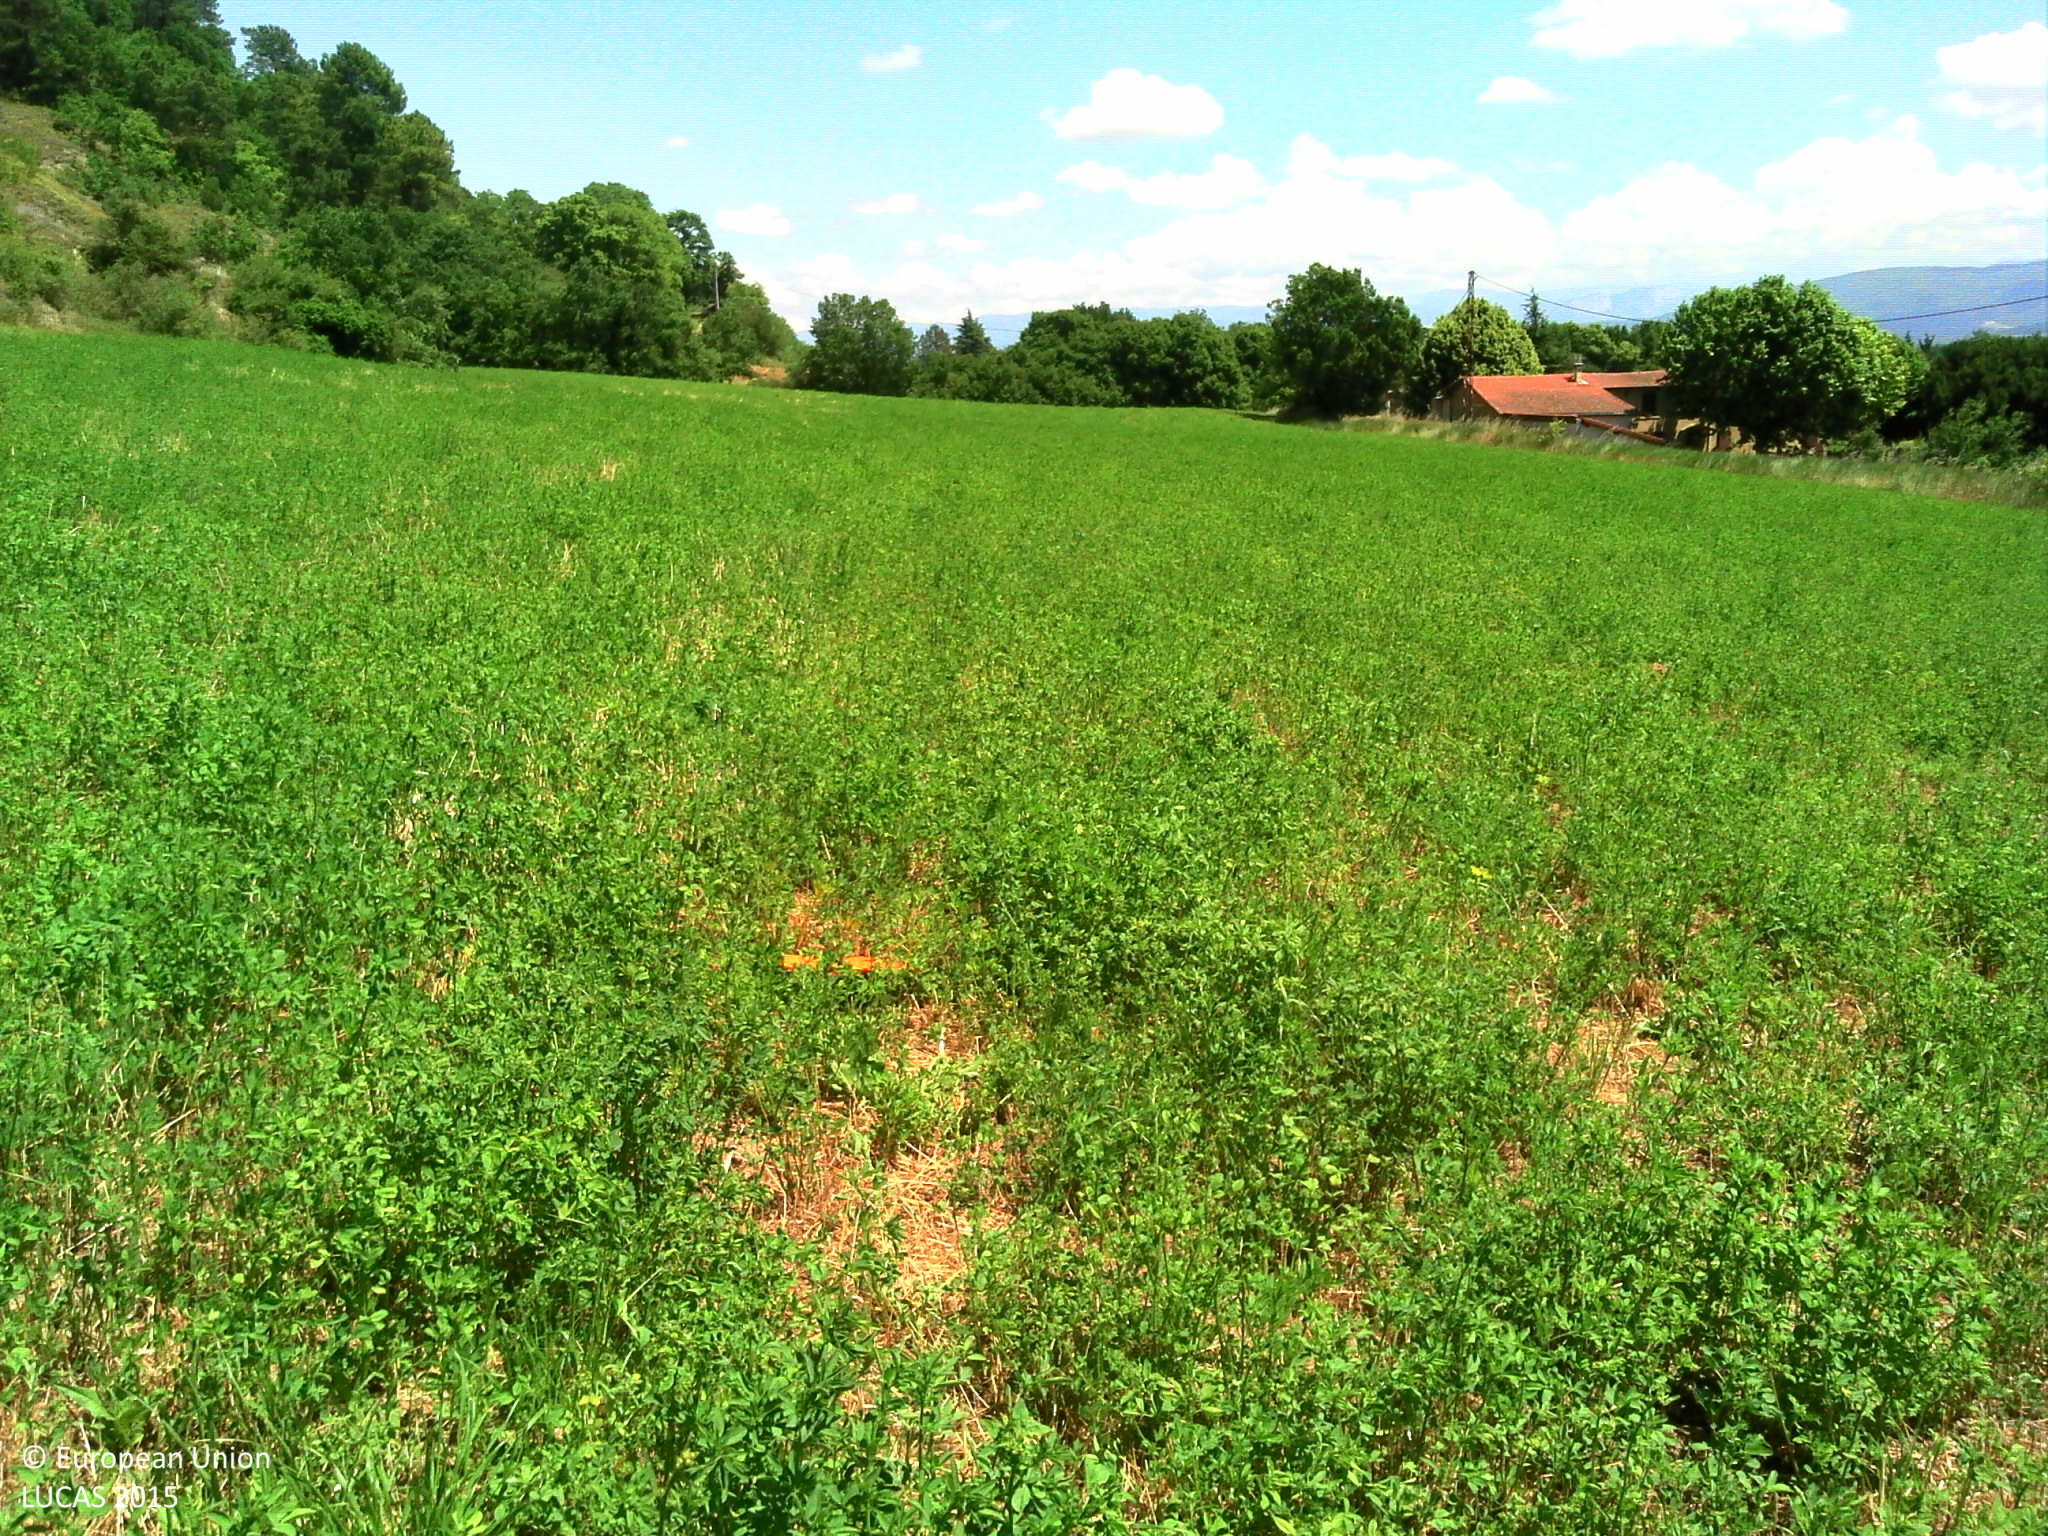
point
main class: Cropland
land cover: Lucerne
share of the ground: > 75 %
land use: Agriculture (excluding fallow land and kitchen gardens)
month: May
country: FR
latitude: 45.0617
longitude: 5.0146
